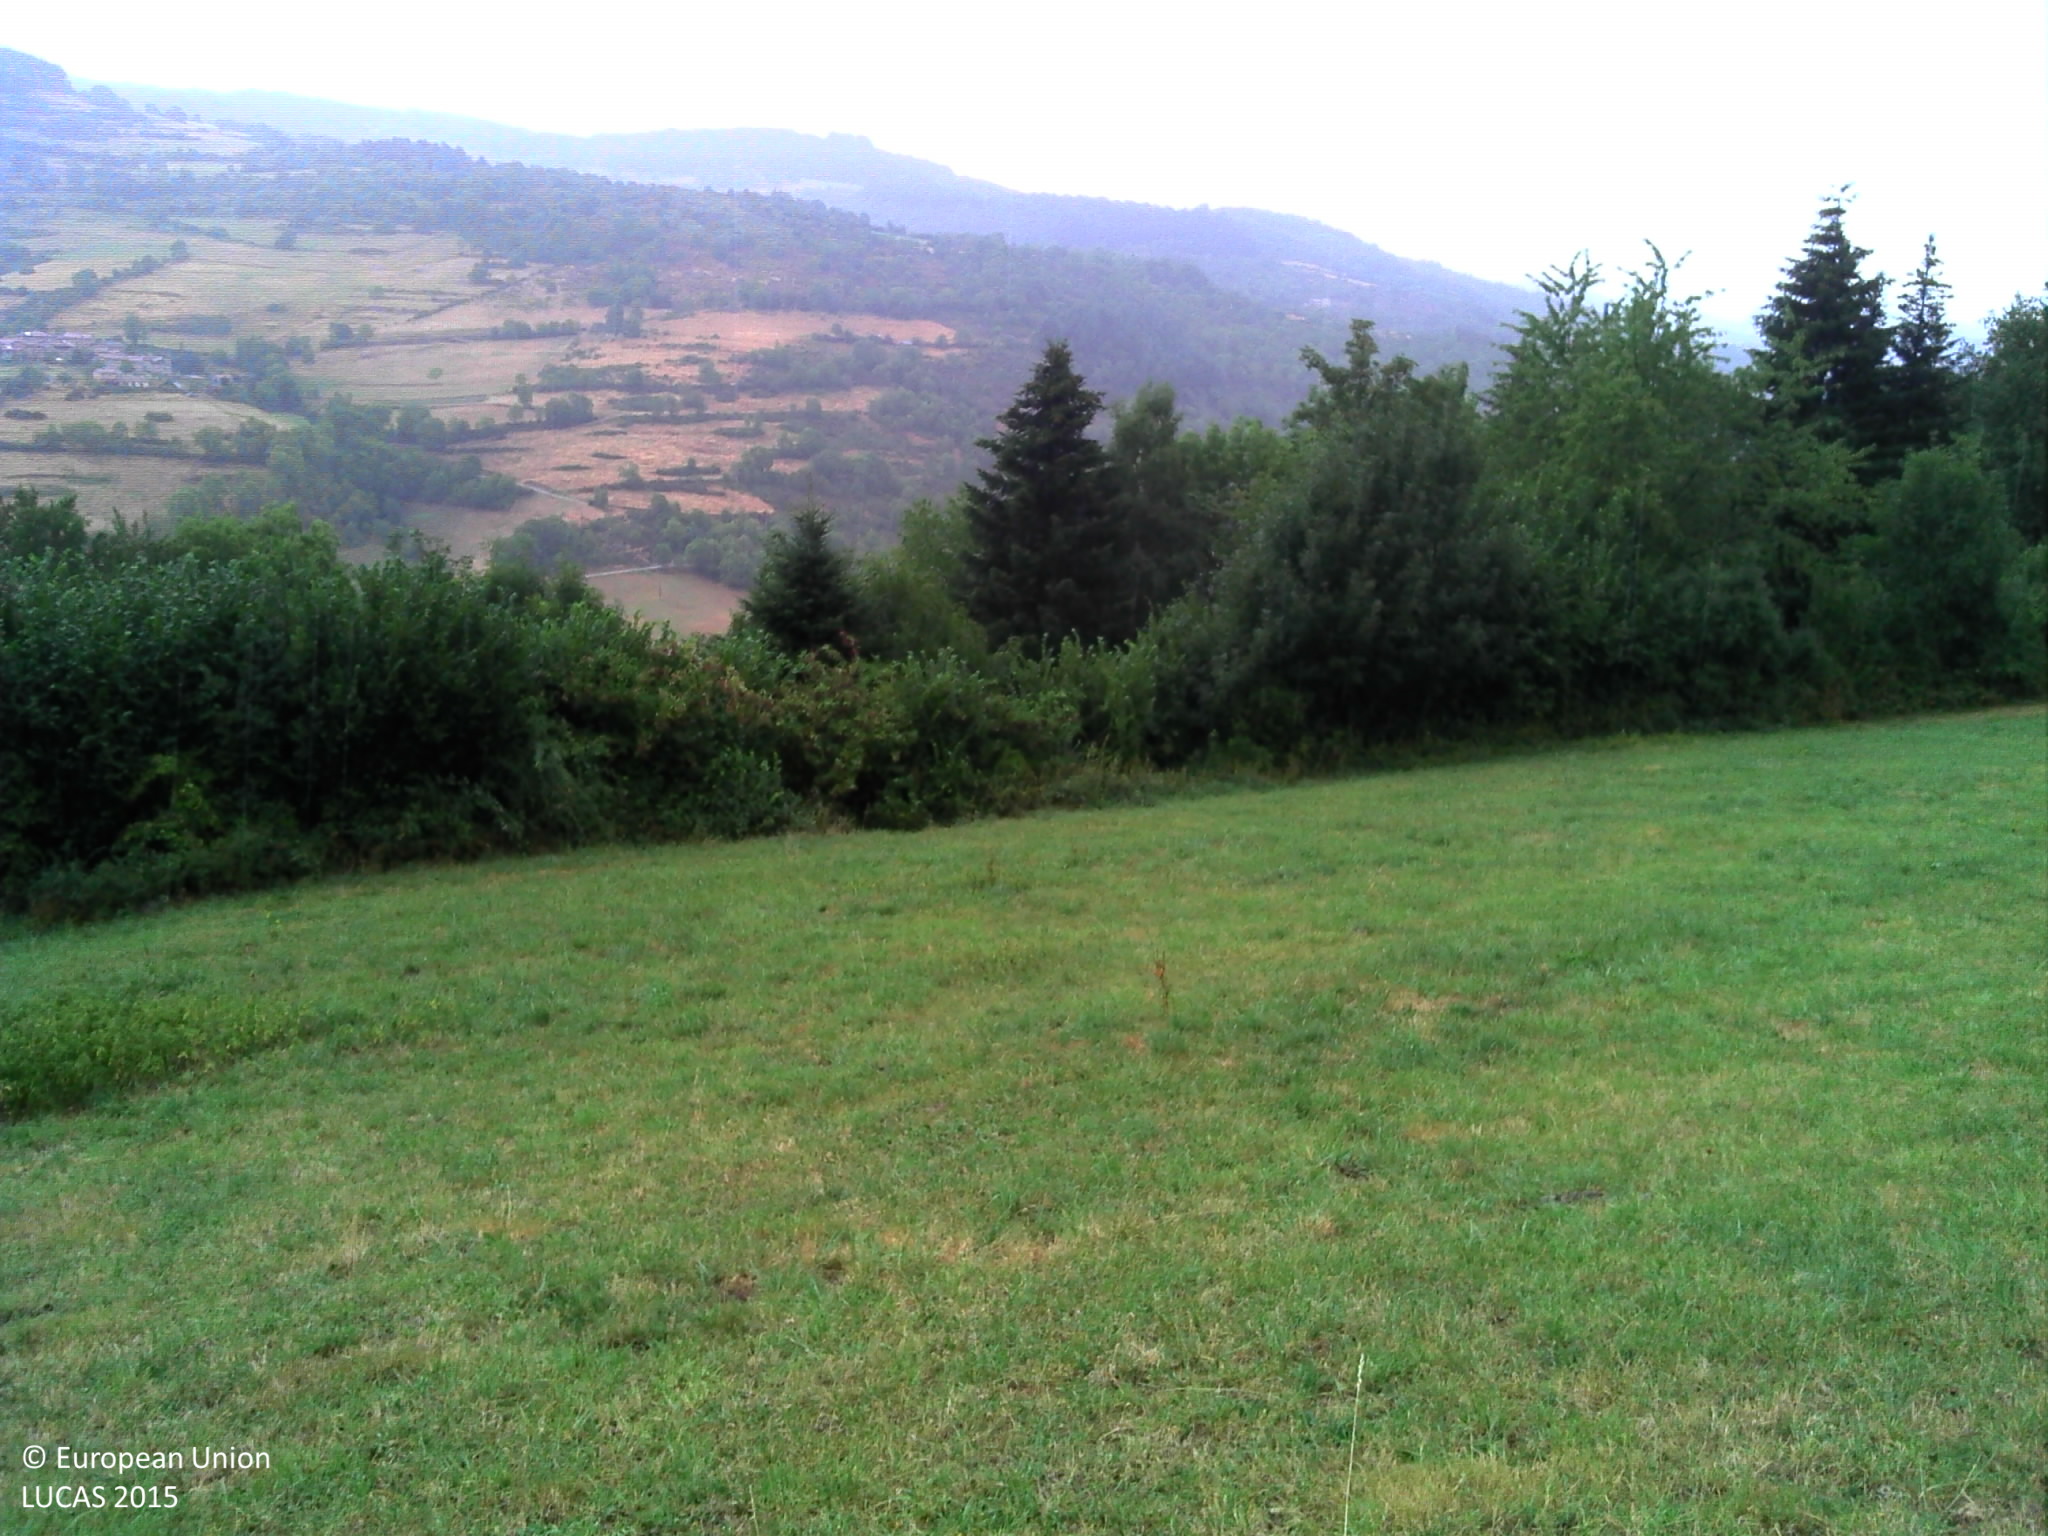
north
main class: Grassland
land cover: Grassland without tree/shrub cover
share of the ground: > 75 %
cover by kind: herbaceous plants 100 %
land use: Agriculture (excluding fallow land and kitchen gardens)
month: August
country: FR
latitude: 45.2713
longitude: 4.5108
